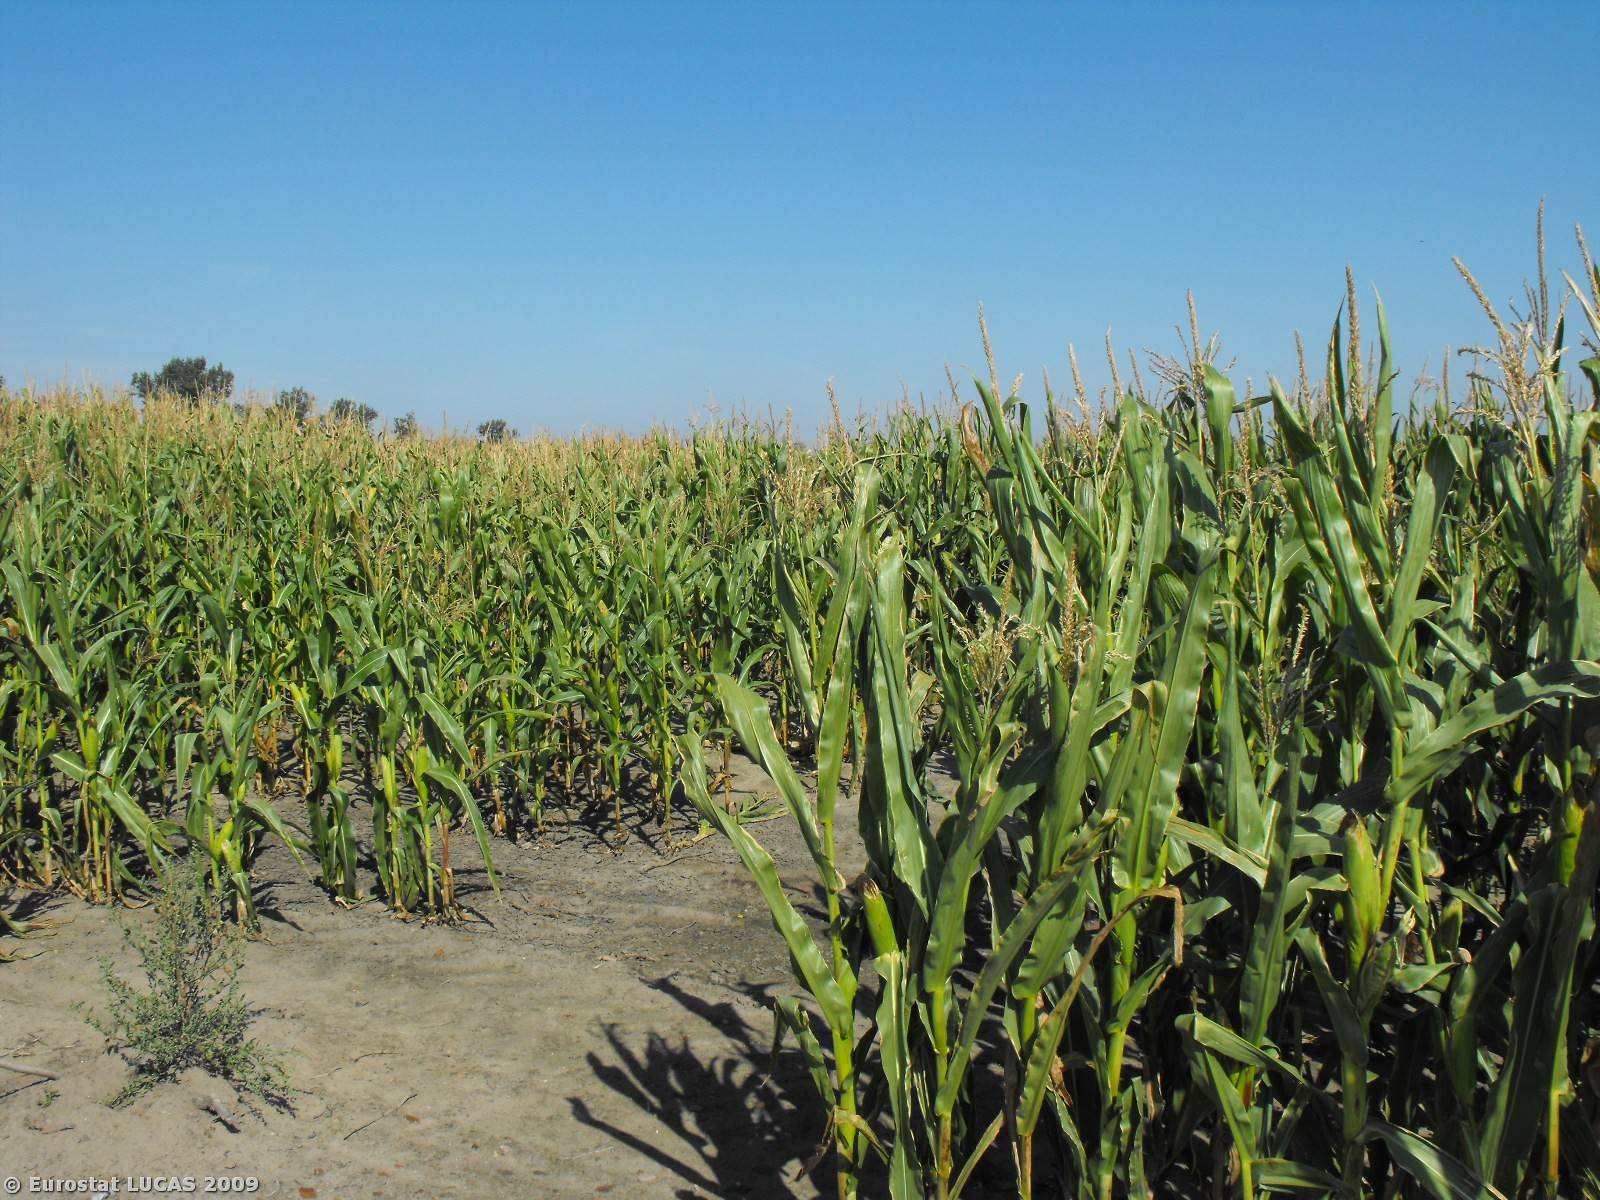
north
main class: Cropland
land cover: Maize
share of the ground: > 75 %
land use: Agriculture (excluding fallow land and kitchen gardens)
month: September
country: PL
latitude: 52.3689
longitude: 16.3665
